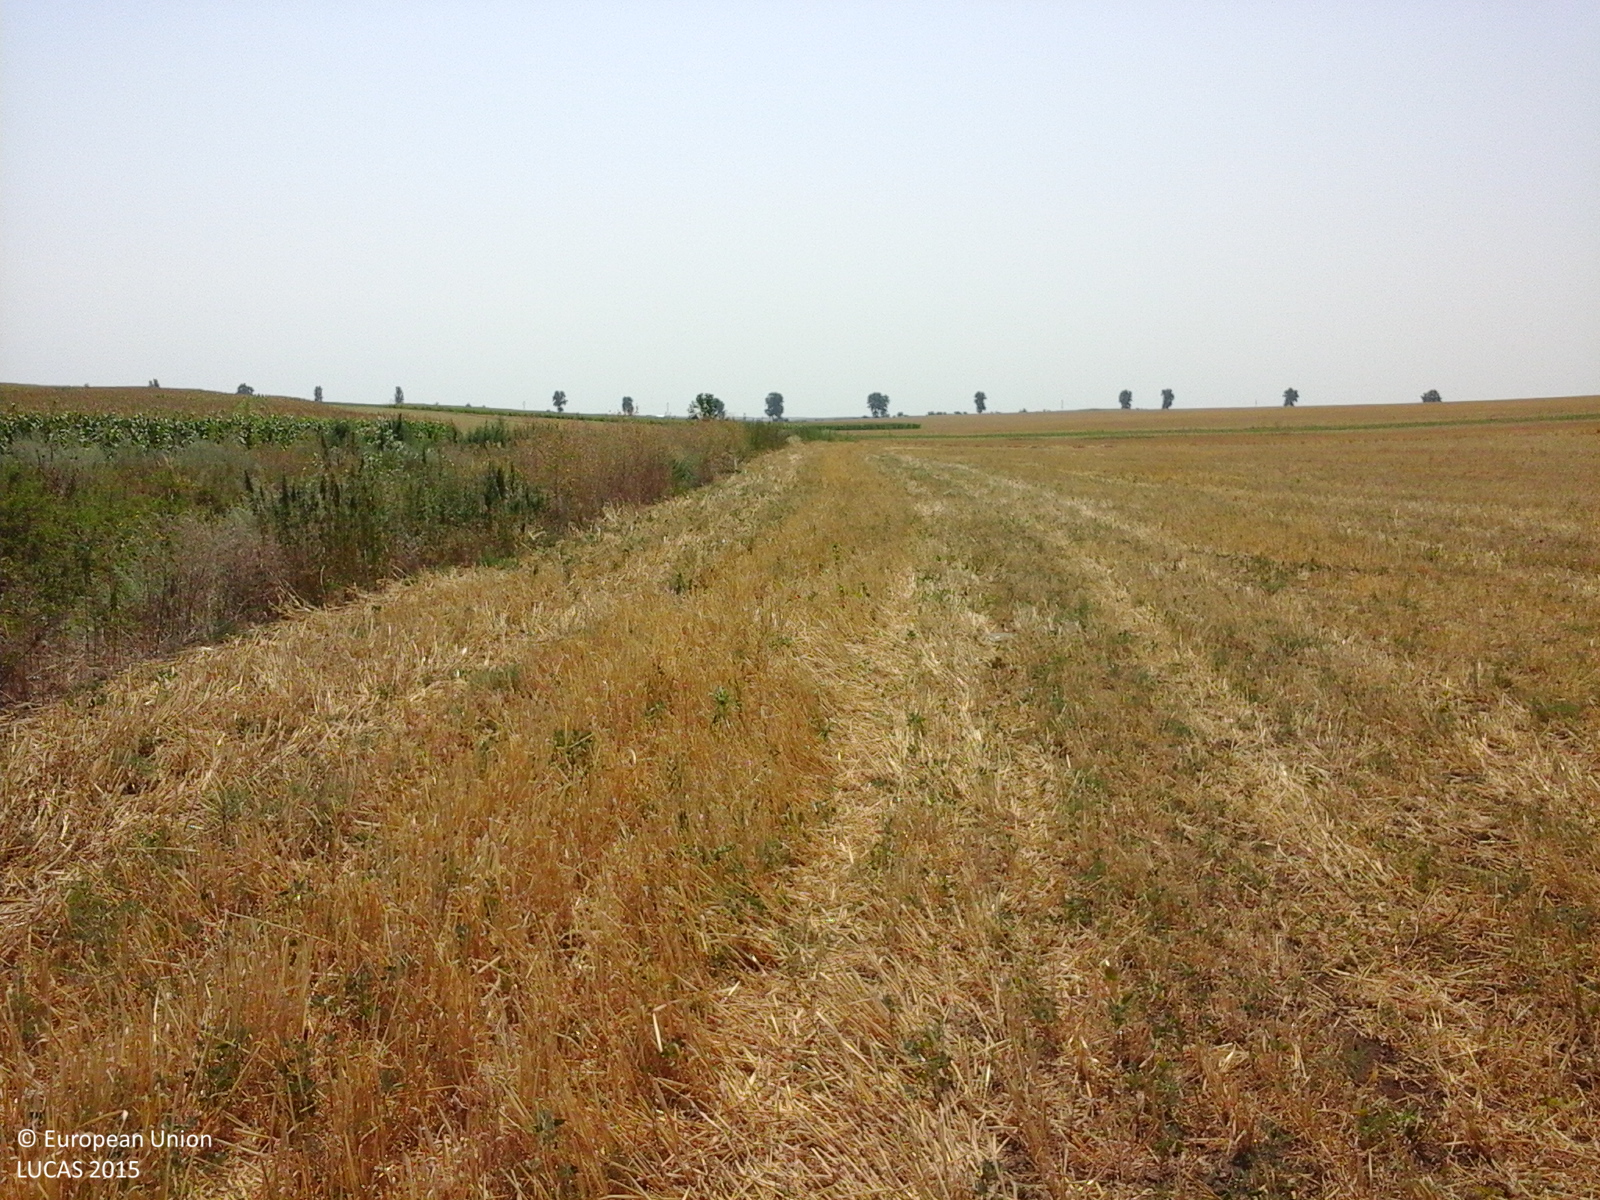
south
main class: Cropland
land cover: Barley
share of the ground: > 75 %
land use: Agriculture (excluding fallow land and kitchen gardens)
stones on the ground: < 10 %
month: July
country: RO
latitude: 45.5084
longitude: 27.8930
